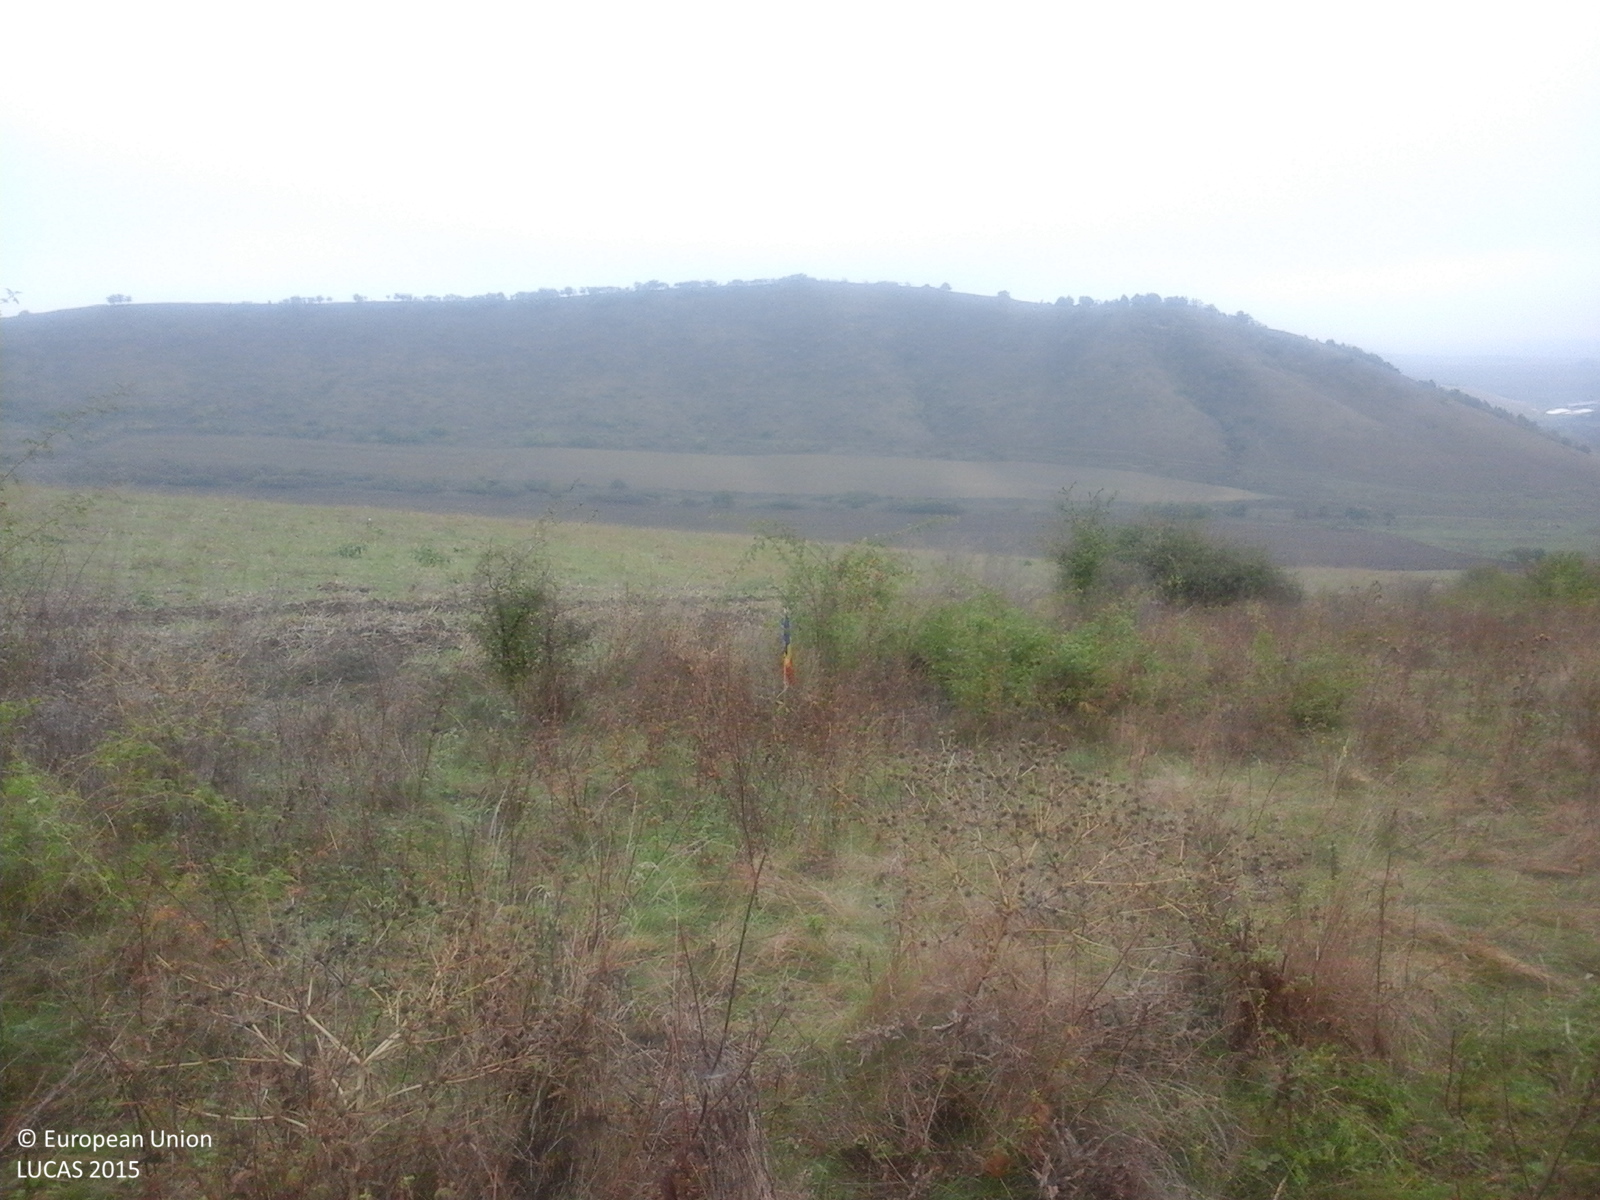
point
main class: Grassland
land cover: Grassland with sparse tree/shrub cover
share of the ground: > 75 %
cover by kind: herbaceous plants 95 %, broadleaved forest trees 5 %
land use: Agriculture (excluding fallow land and kitchen gardens)
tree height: < 5 m
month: October
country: RO
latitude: 46.5941
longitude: 24.1380
